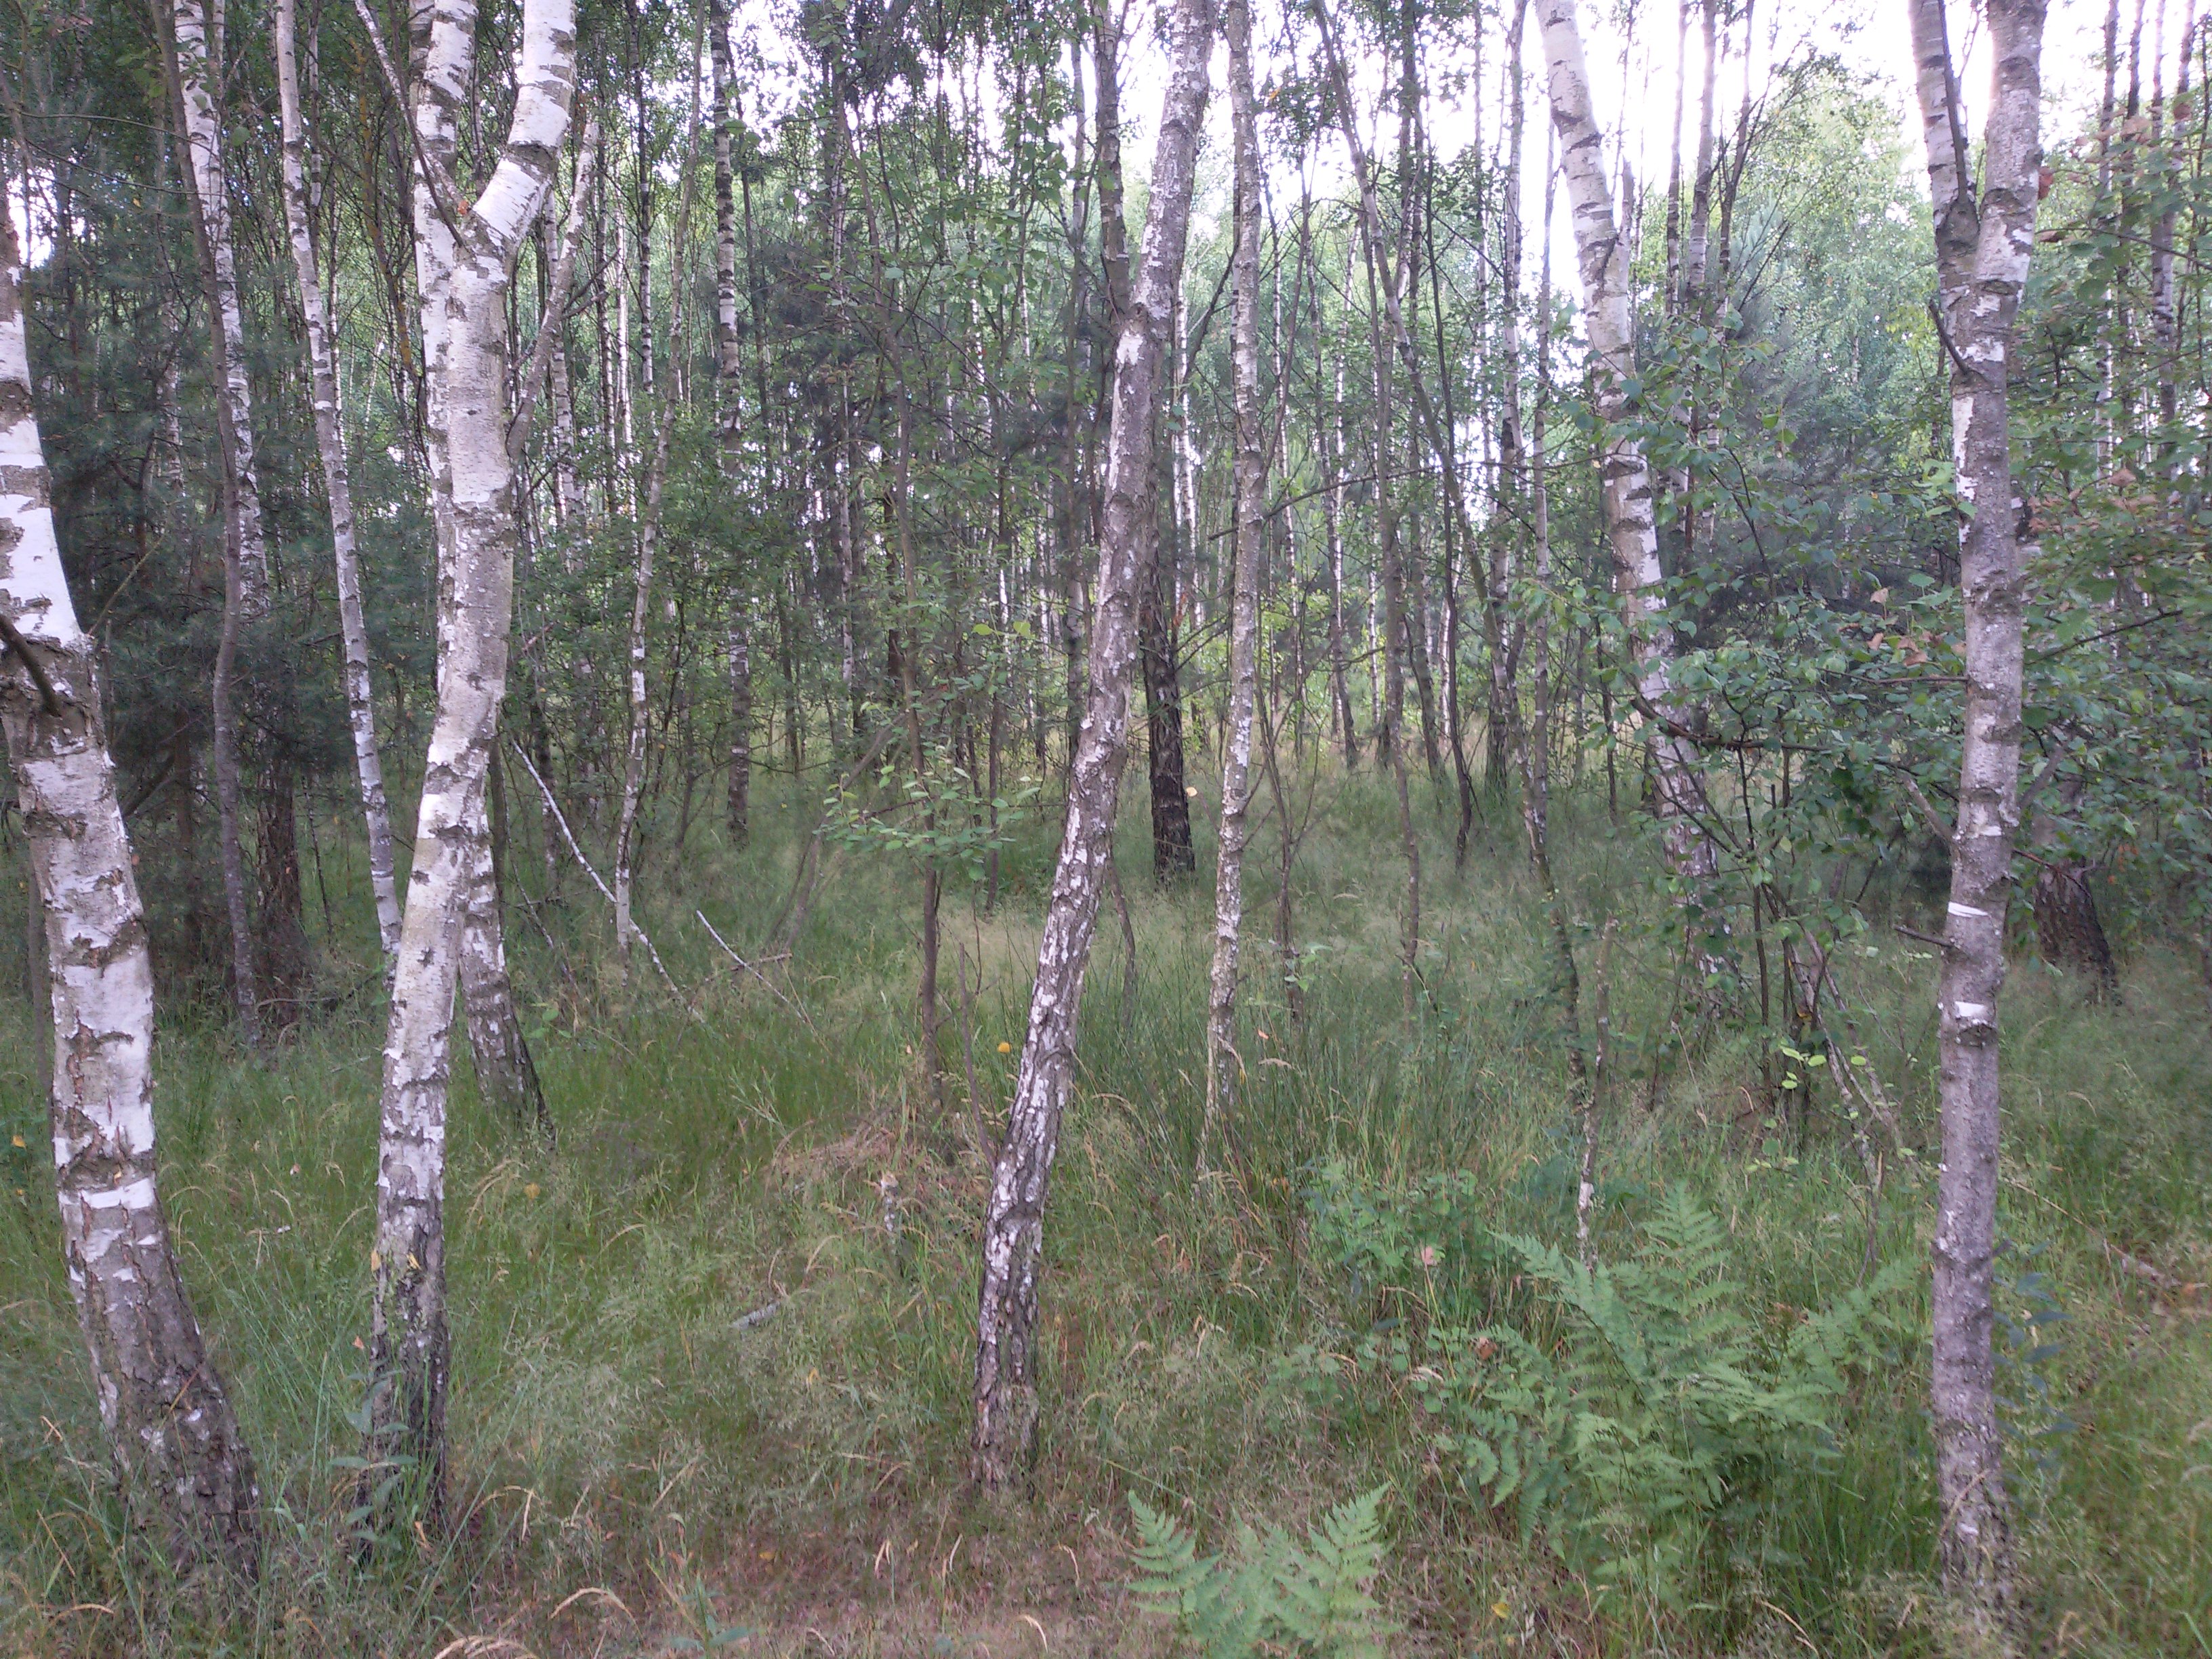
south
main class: Woodland
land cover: Broadleaved woodland
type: mesophytic deciduous forest
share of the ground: > 75 %
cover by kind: broadleaved forest trees 85 %, herbaceous plants 10 %, shrubs 5 %
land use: Forestry
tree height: > 5 m
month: June
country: PL
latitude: 51.8513
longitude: 23.0697
